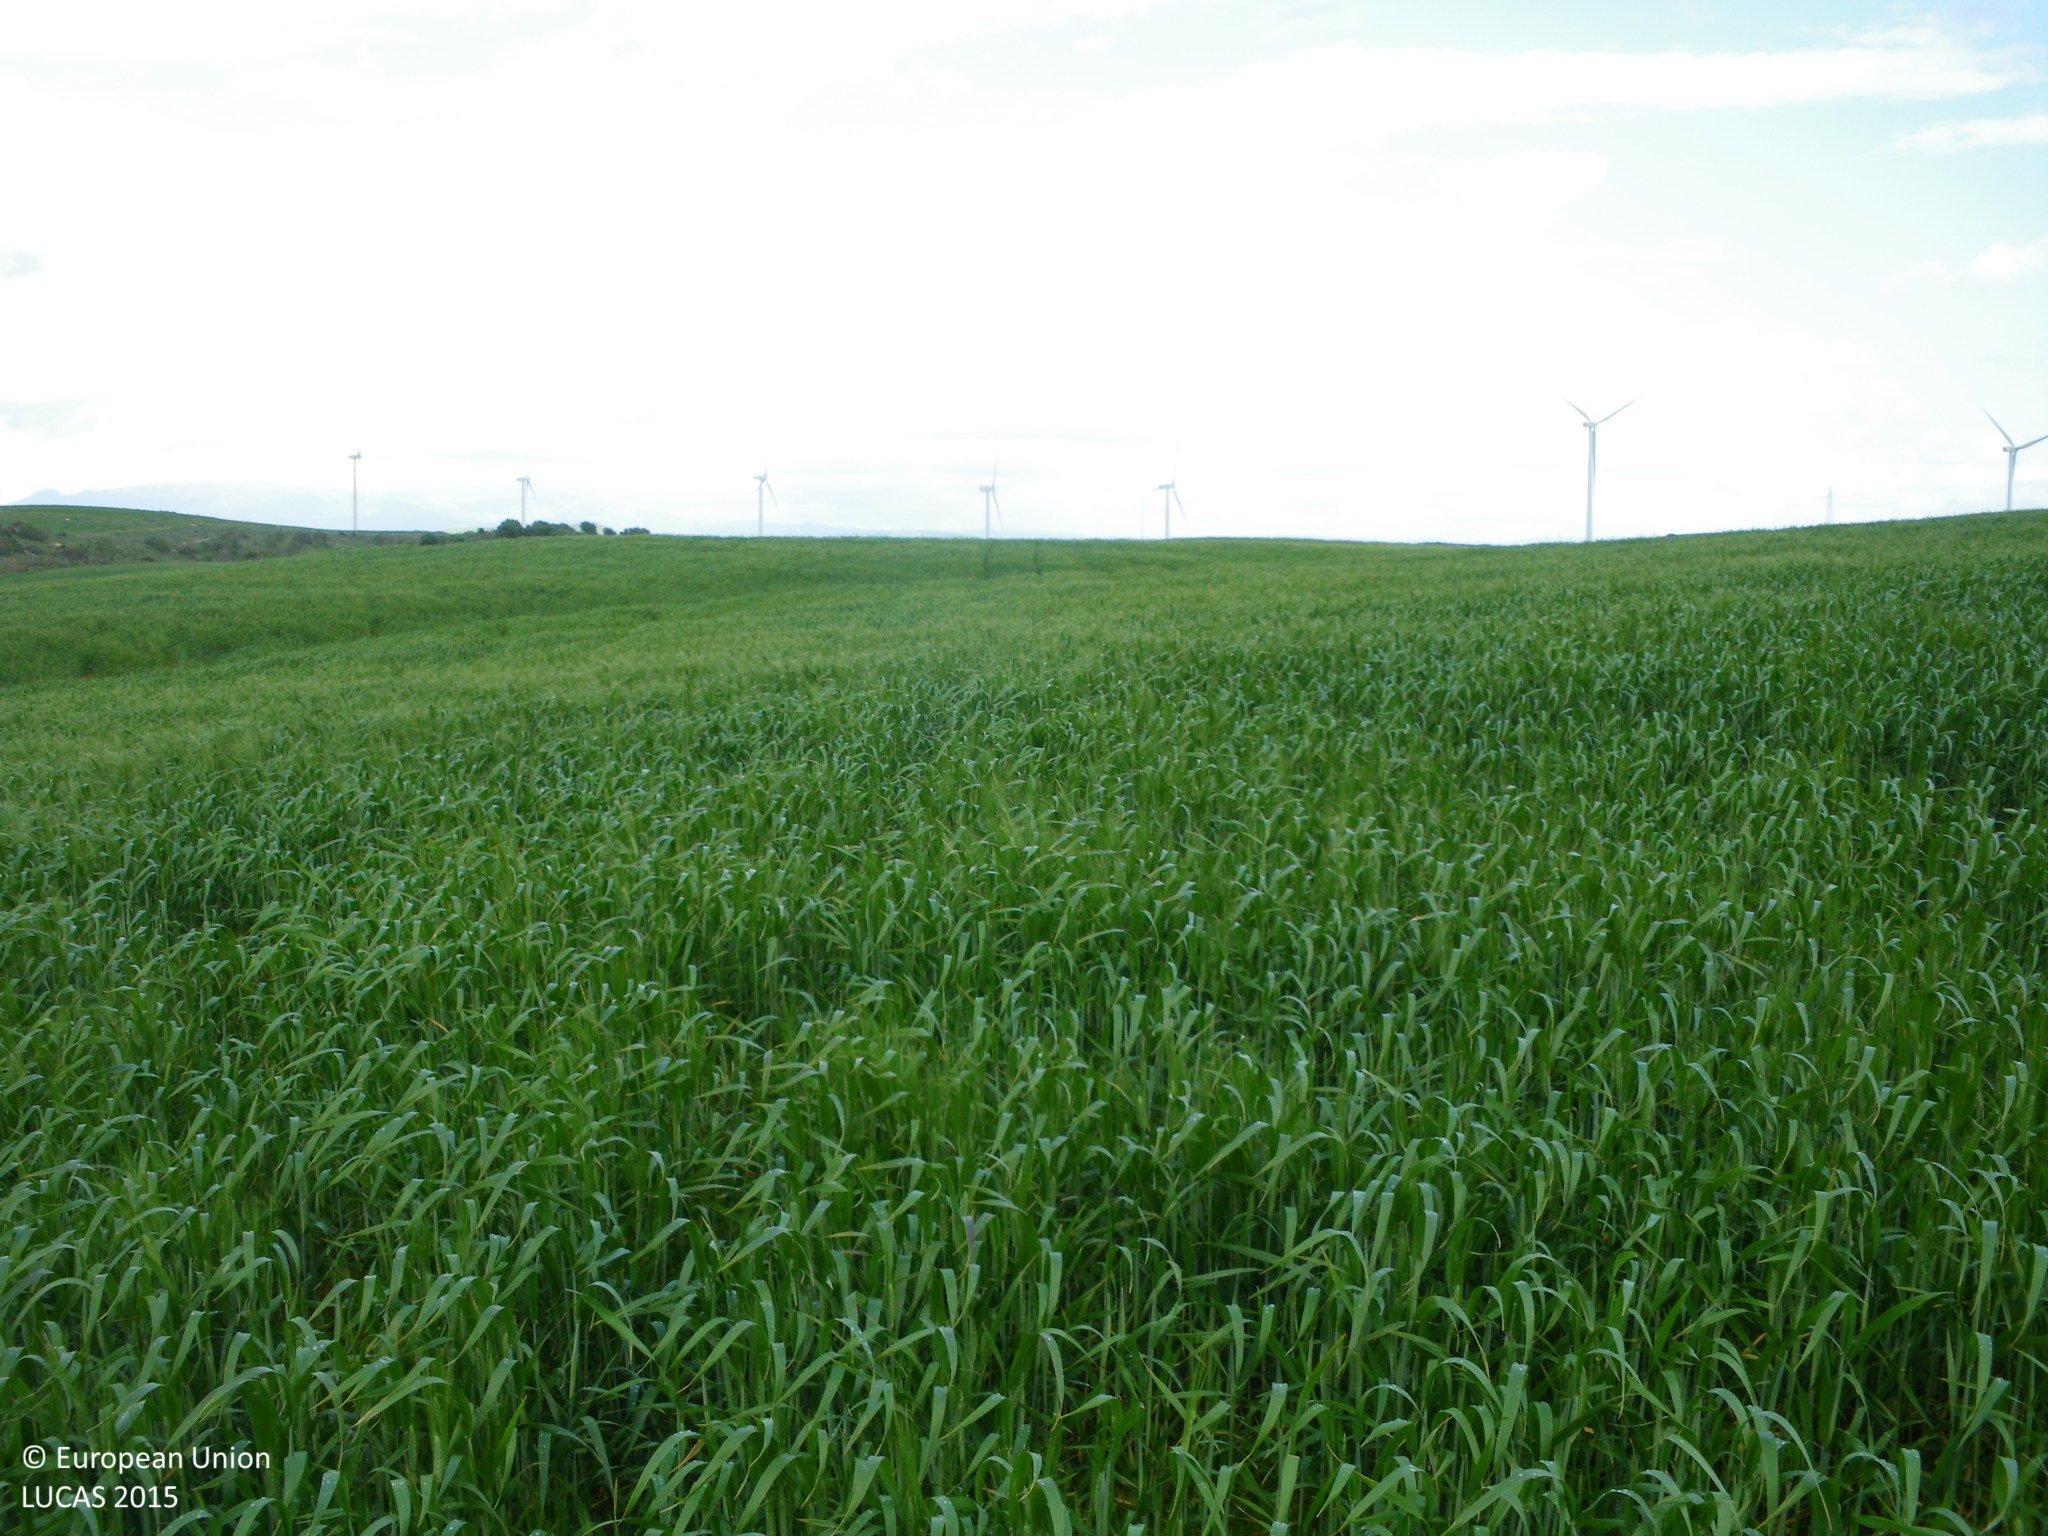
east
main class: Cropland
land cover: Durum wheat
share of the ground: > 75 %
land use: Agriculture (excluding fallow land and kitchen gardens)
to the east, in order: Durum wheat; Other structural elements; Durum wheat; Single bushes/trees; Durum wheat; Grass margins; Other structural elements; Grassland without tree/shrub cover
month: April
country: ES
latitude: 36.4766
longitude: -5.8863
